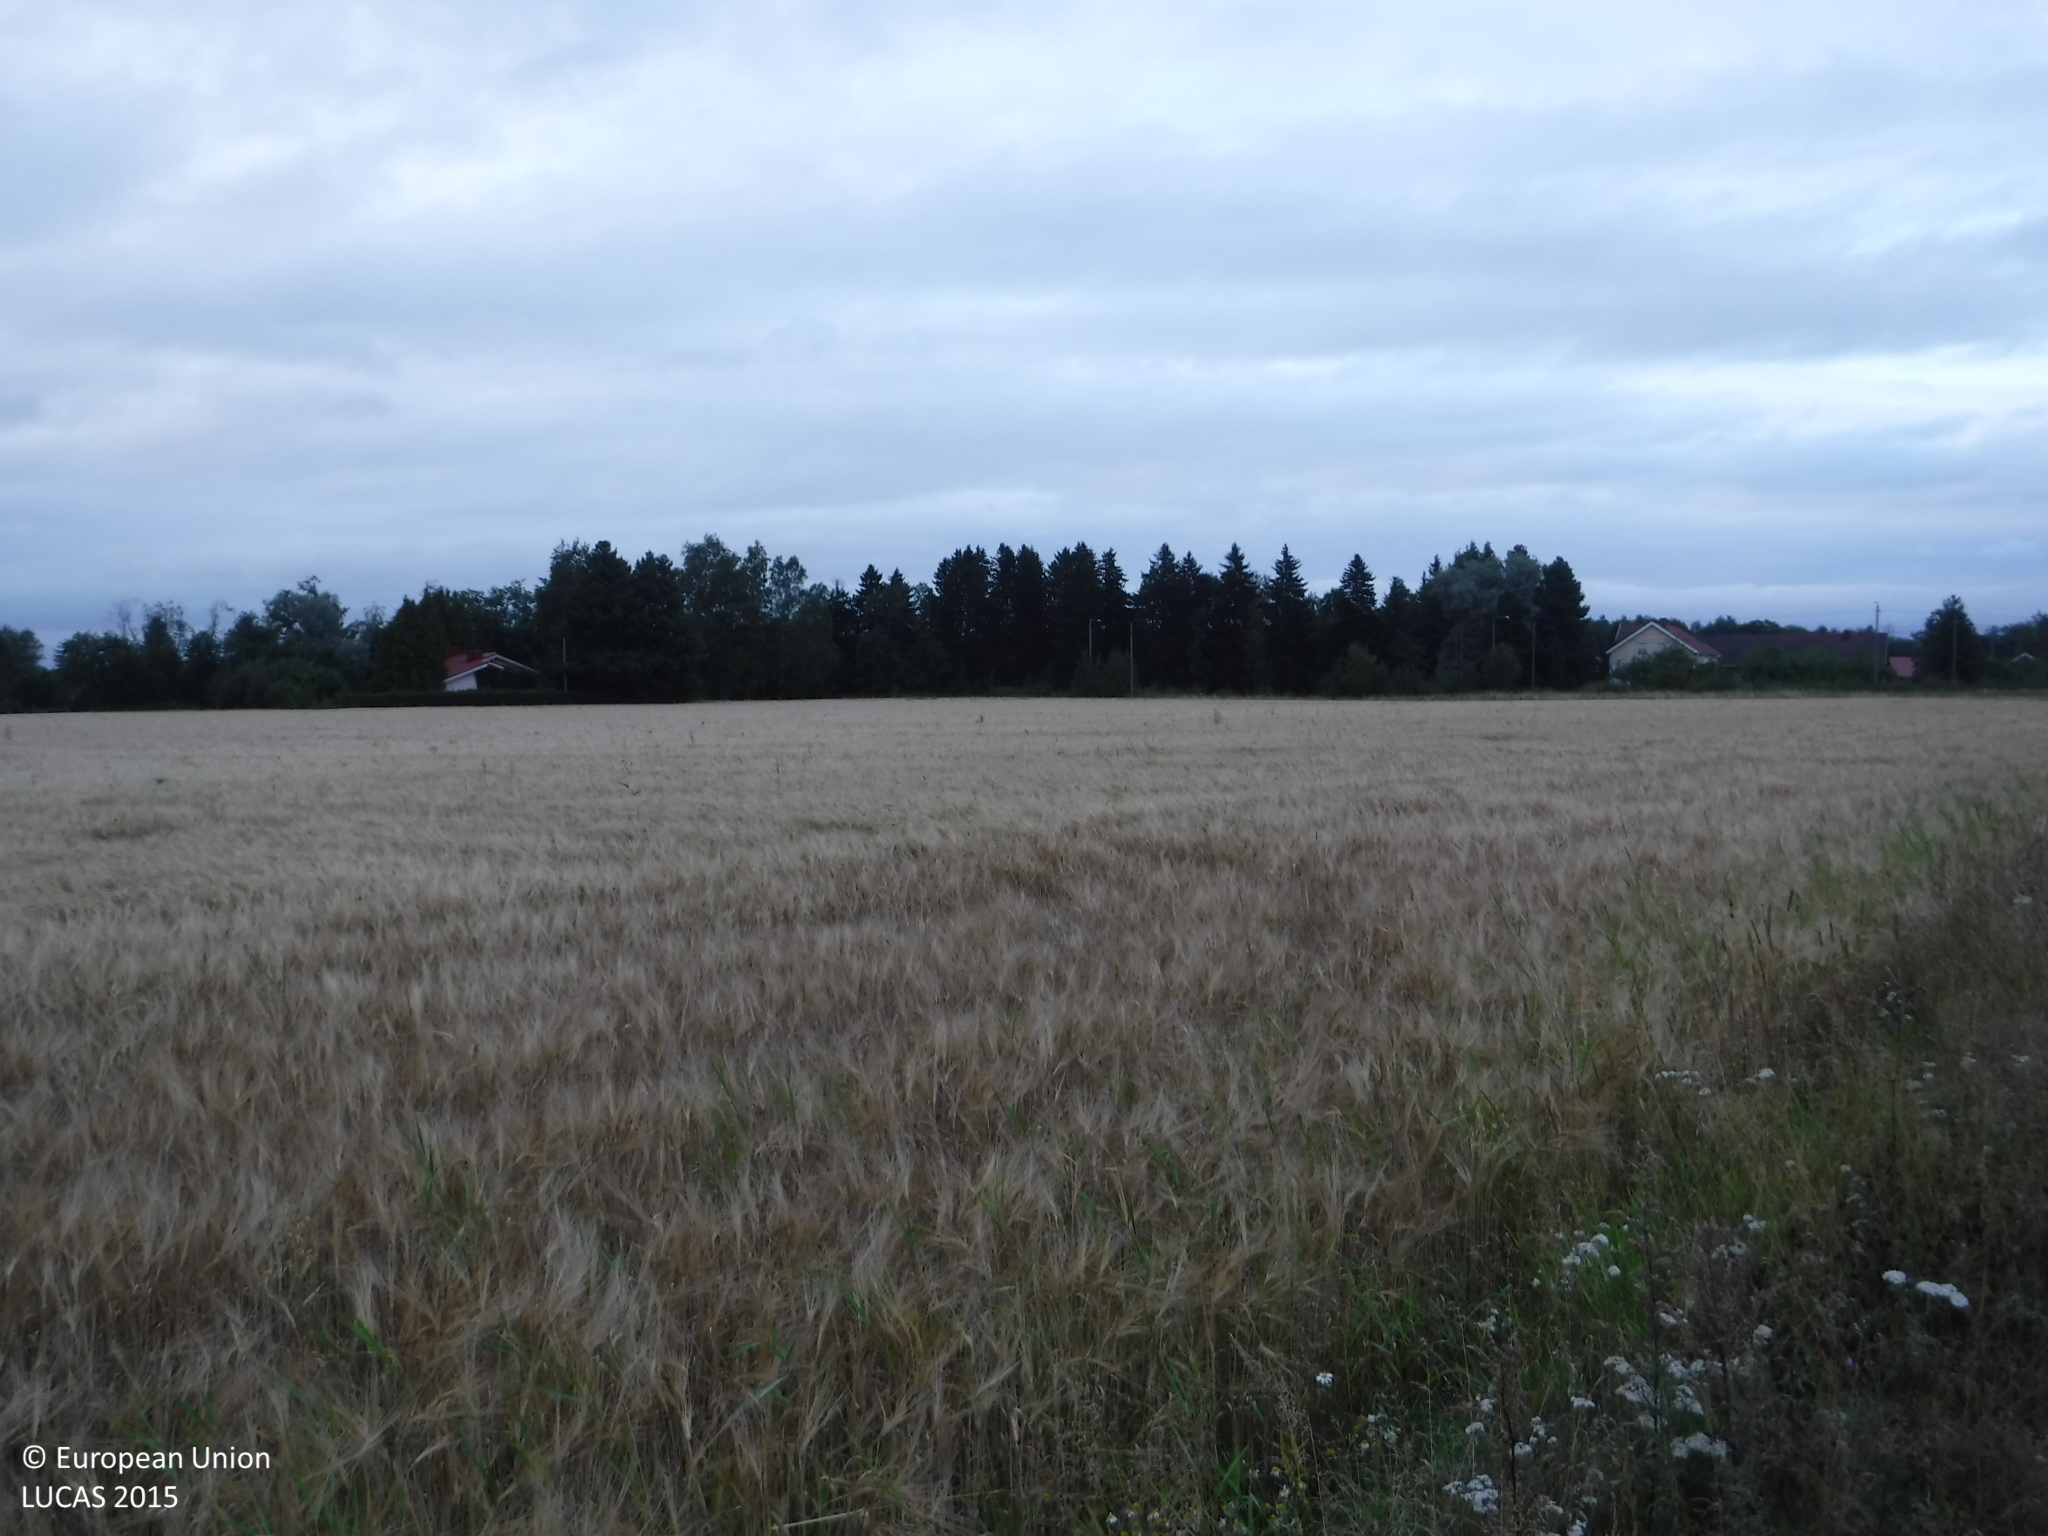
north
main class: Cropland
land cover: Barley
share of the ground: > 75 %
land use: Agriculture (excluding fallow land and kitchen gardens)
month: September
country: FI
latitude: 61.3833
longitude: 21.9796
